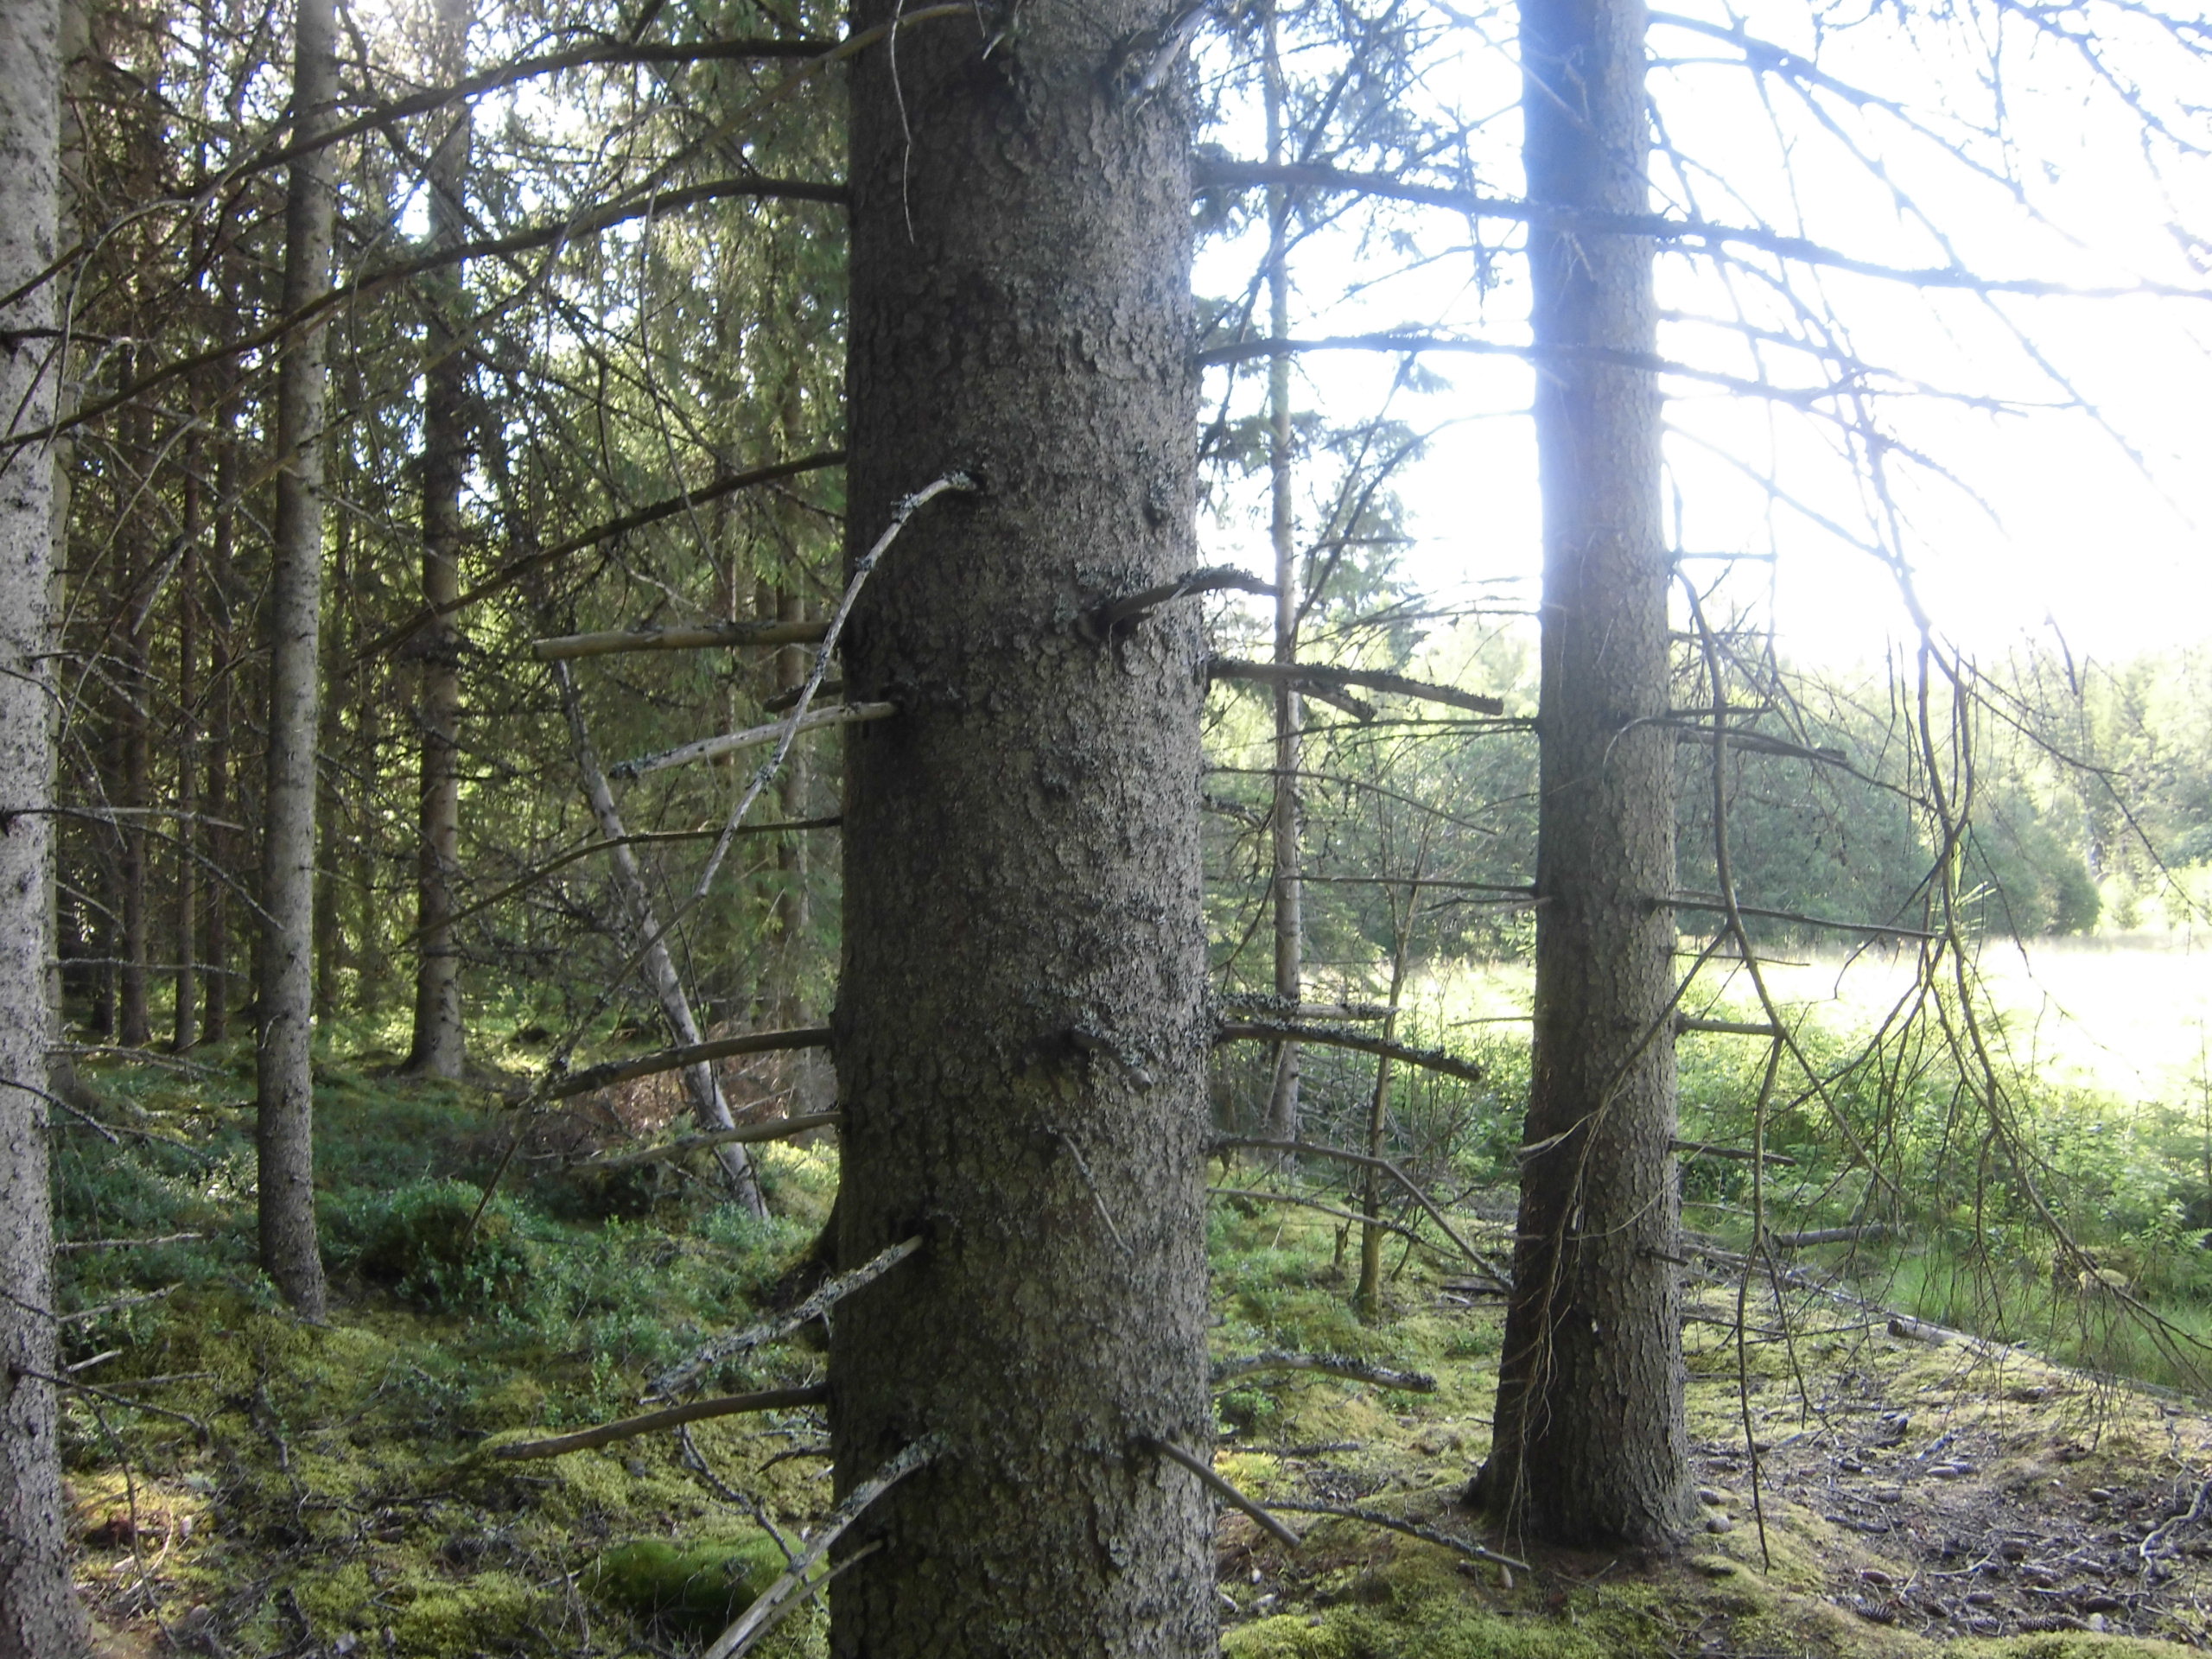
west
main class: Woodland
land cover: Spruce dominated coniferous woodland
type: boreal forest
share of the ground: 50 - 75 %
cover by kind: coniferous forest trees 60 %, shrubs 20 %, herbaceous plants 10 %, lichens and mosses 10 %
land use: Forestry
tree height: > 5 m
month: July
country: SE
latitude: 57.1774
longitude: 15.3070
